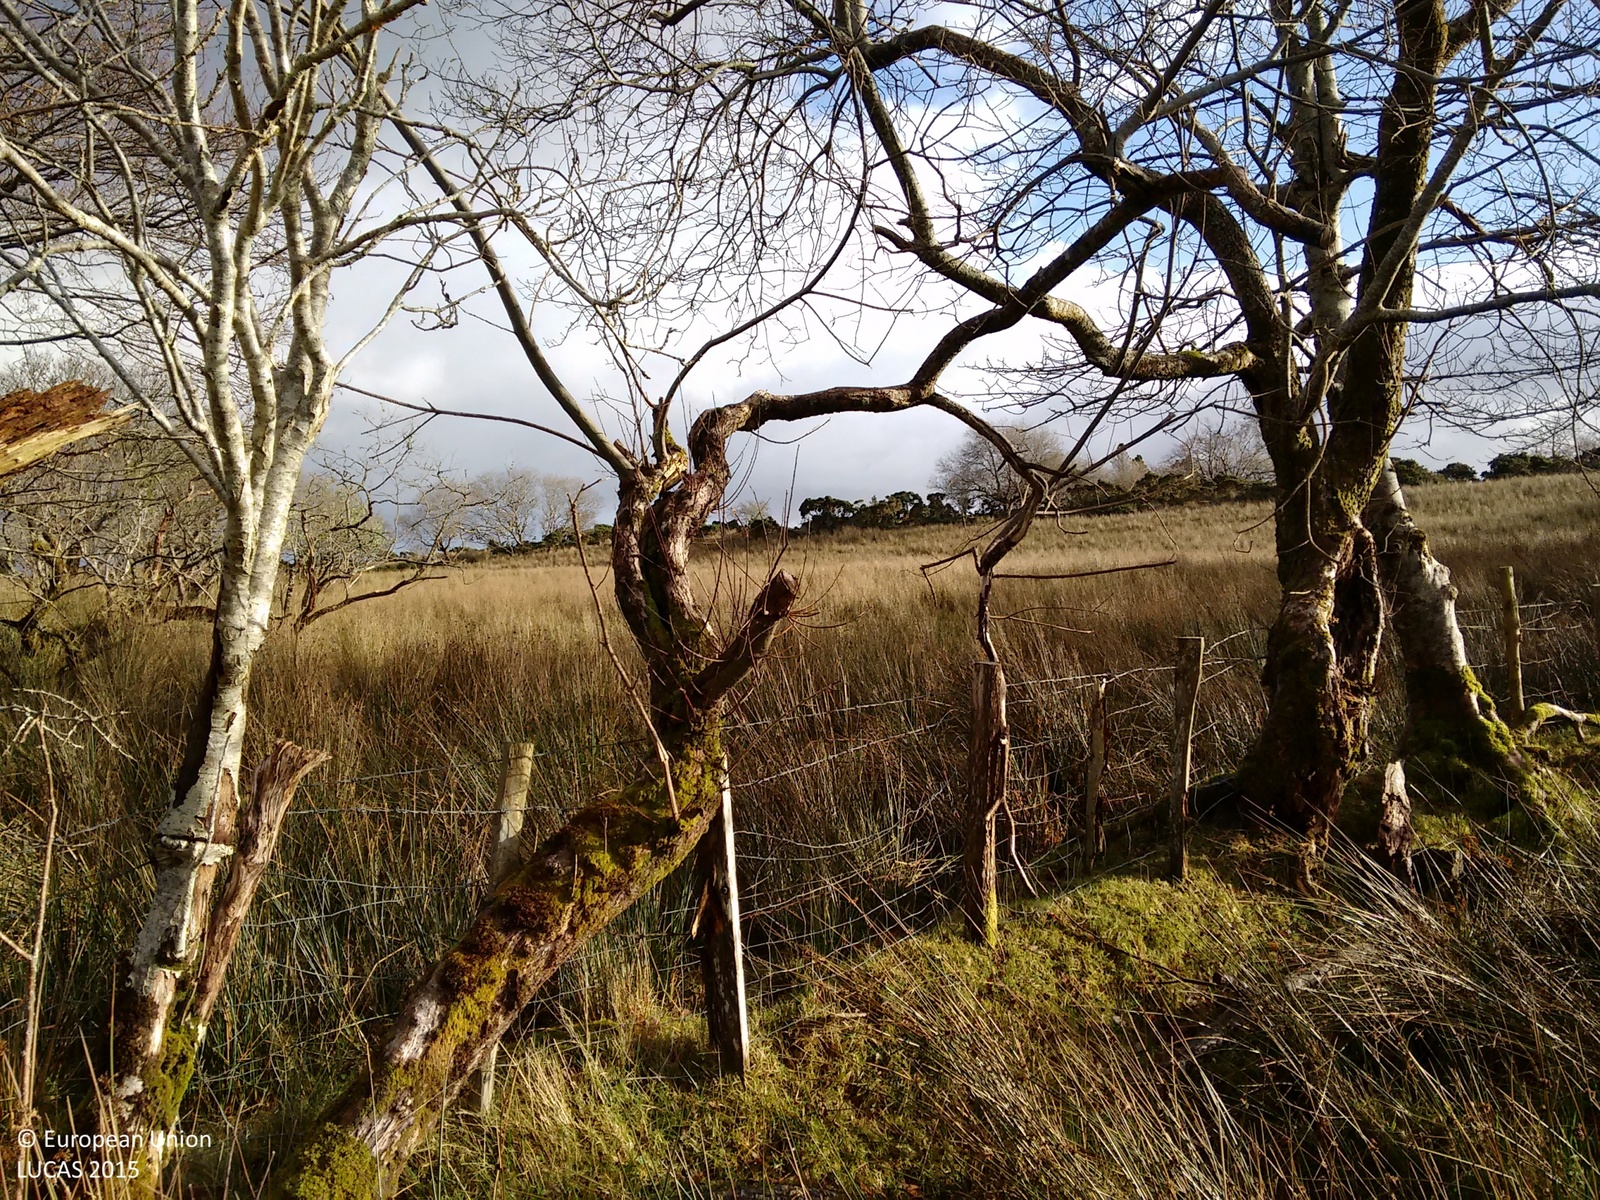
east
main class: Grassland
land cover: Grassland without tree/shrub cover
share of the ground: > 75 %
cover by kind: herbaceous plants 100 %
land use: Agriculture (excluding fallow land and kitchen gardens)
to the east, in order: Abandoned hedges; Grassland without tree/shrub cover; Abandoned hedges; Grassland without tree/shrub cover; Abandoned hedges; Fences; Grassland without tree/shrub cover; Abandoned hedges; Fences; Grassland without tree/shrub cover; Broadleaved woodland
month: November
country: IE
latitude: 54.6681
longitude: -8.1804
